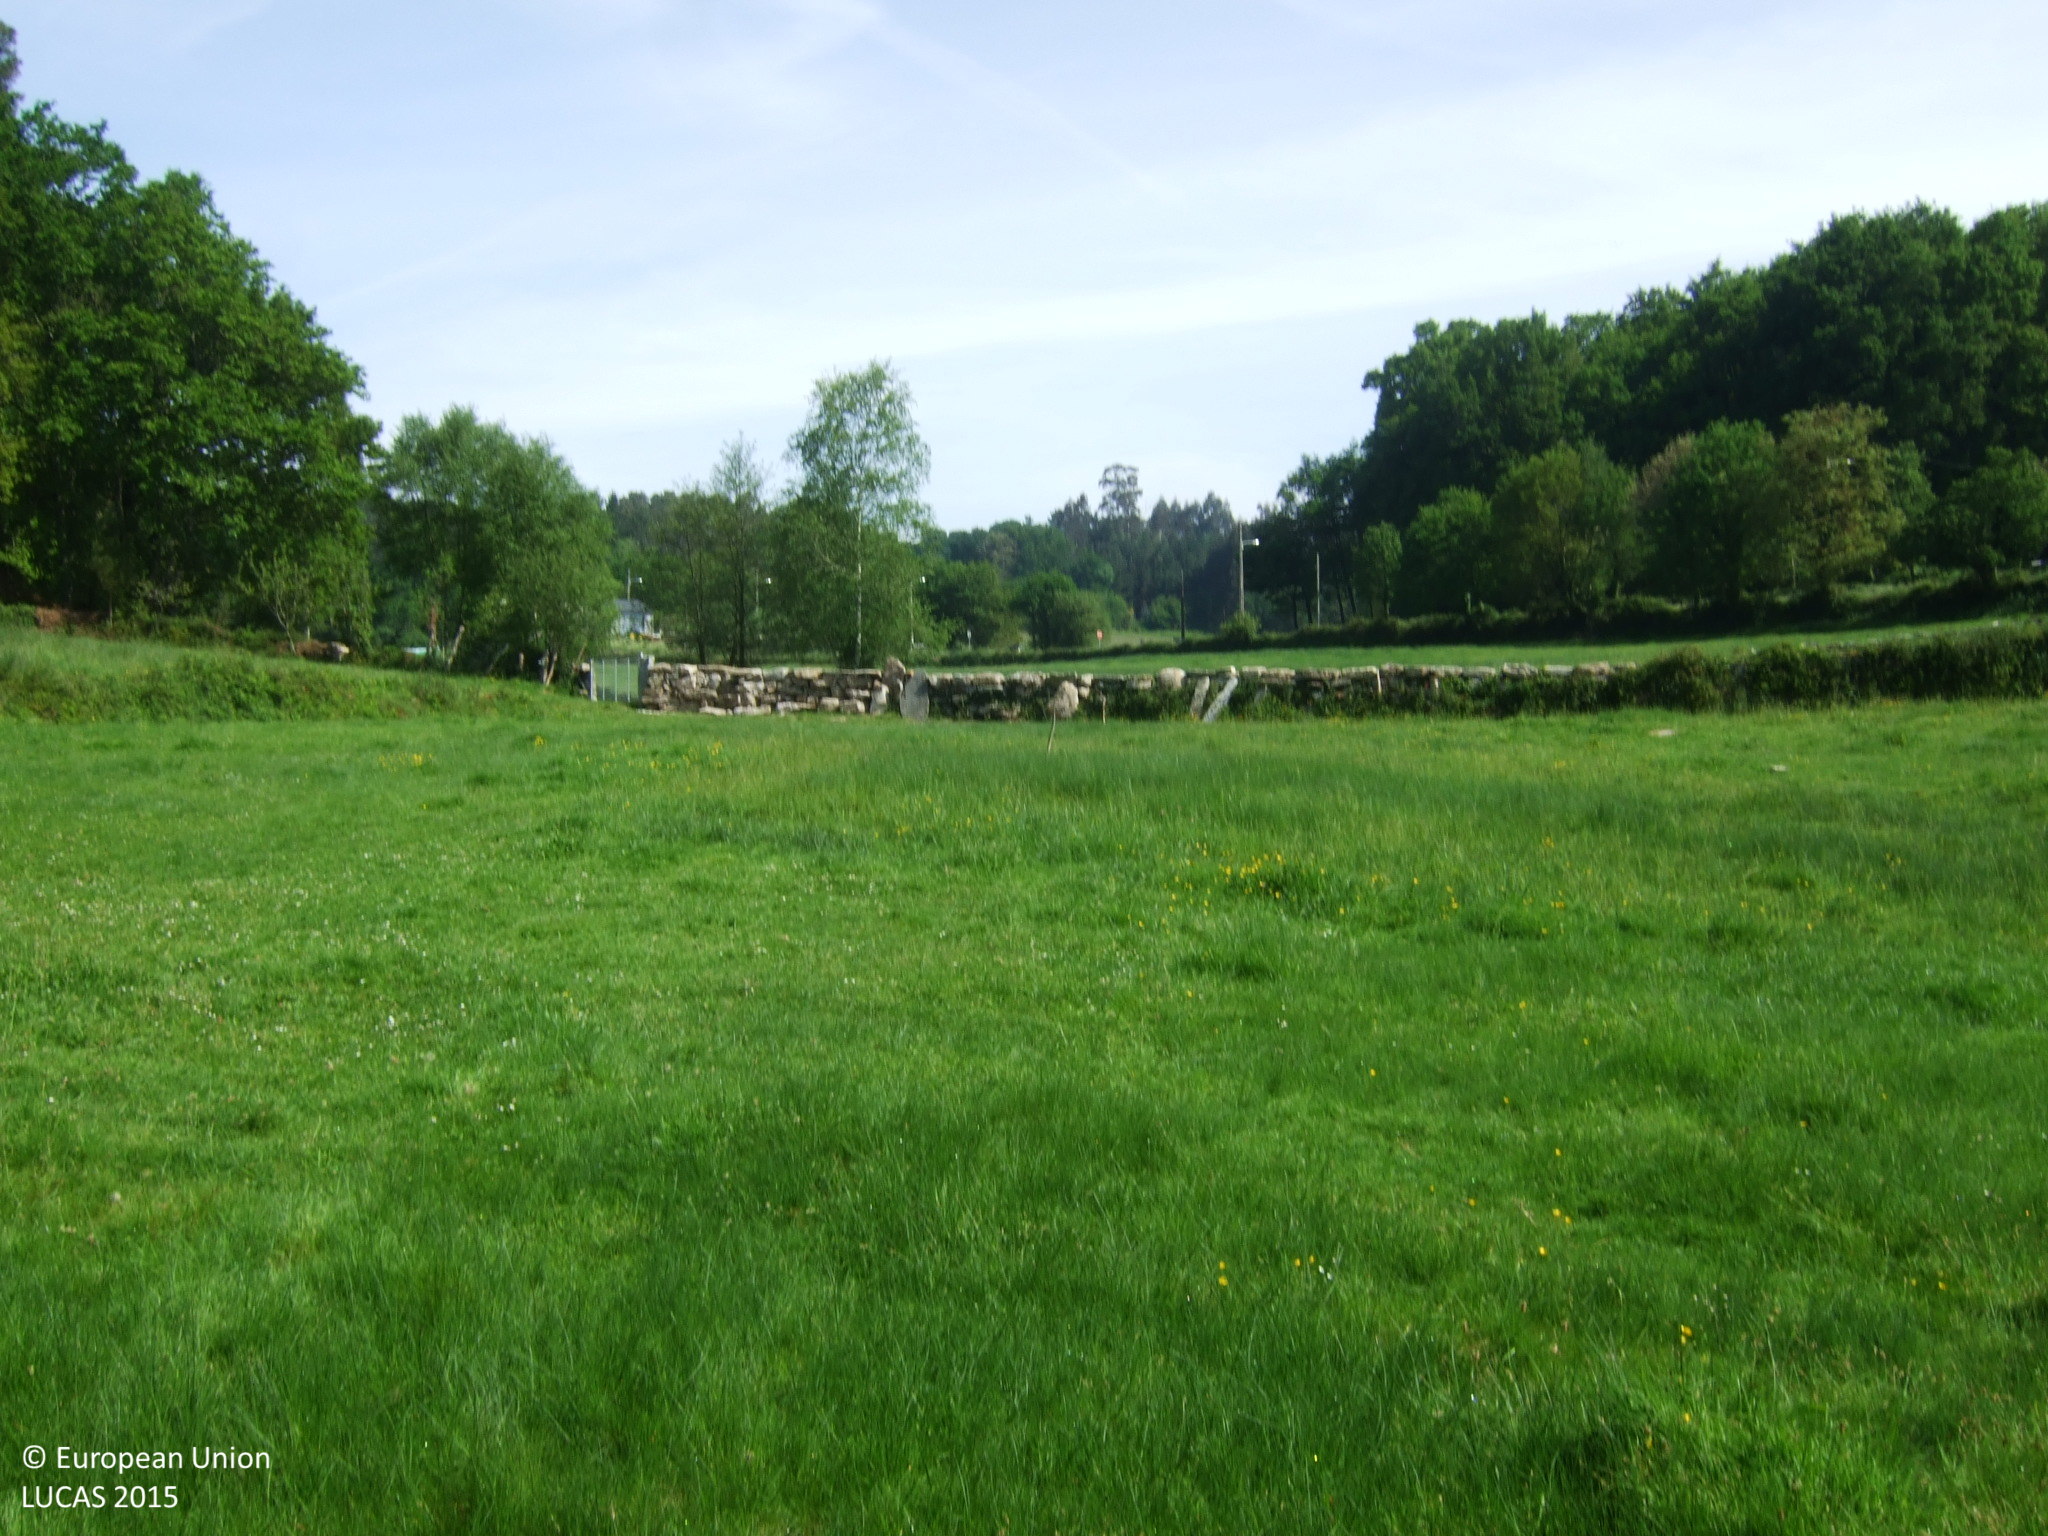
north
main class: Grassland
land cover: Grassland without tree/shrub cover
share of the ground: > 75 %
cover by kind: herbaceous plants 100 %
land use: Agriculture (excluding fallow land and kitchen gardens)
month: May
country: ES
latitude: 43.0082
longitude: -7.4335
